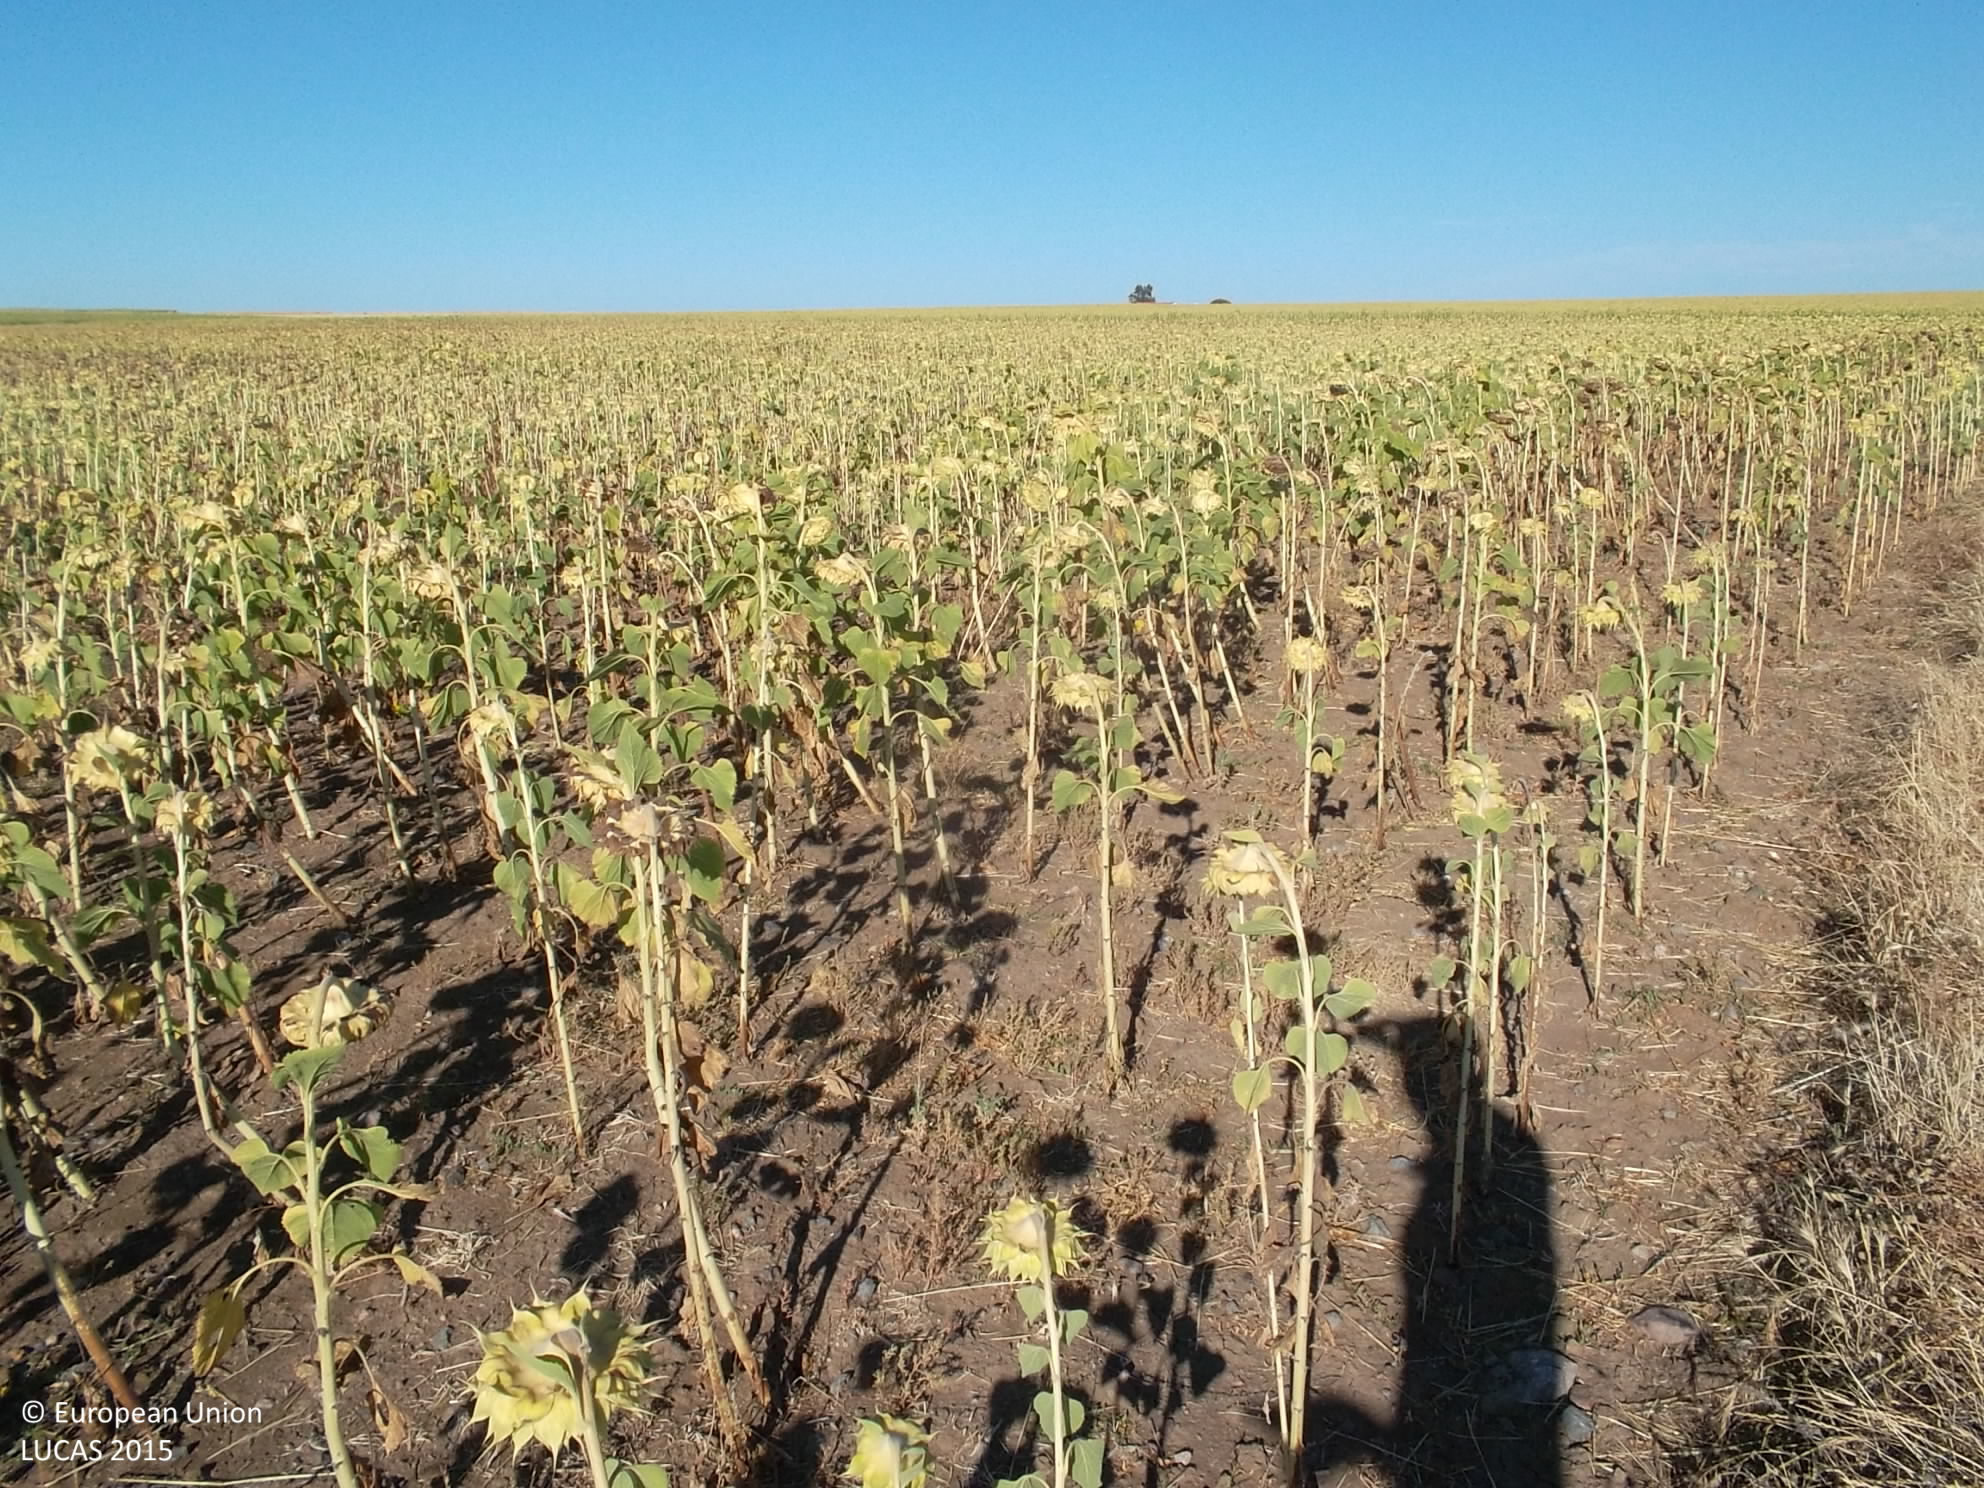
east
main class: Artificial land
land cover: Non built-up linear features
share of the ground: > 75 %
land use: Road transport
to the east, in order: Sunflower; Tracks
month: July
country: ES
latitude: 38.3111
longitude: -5.7152
